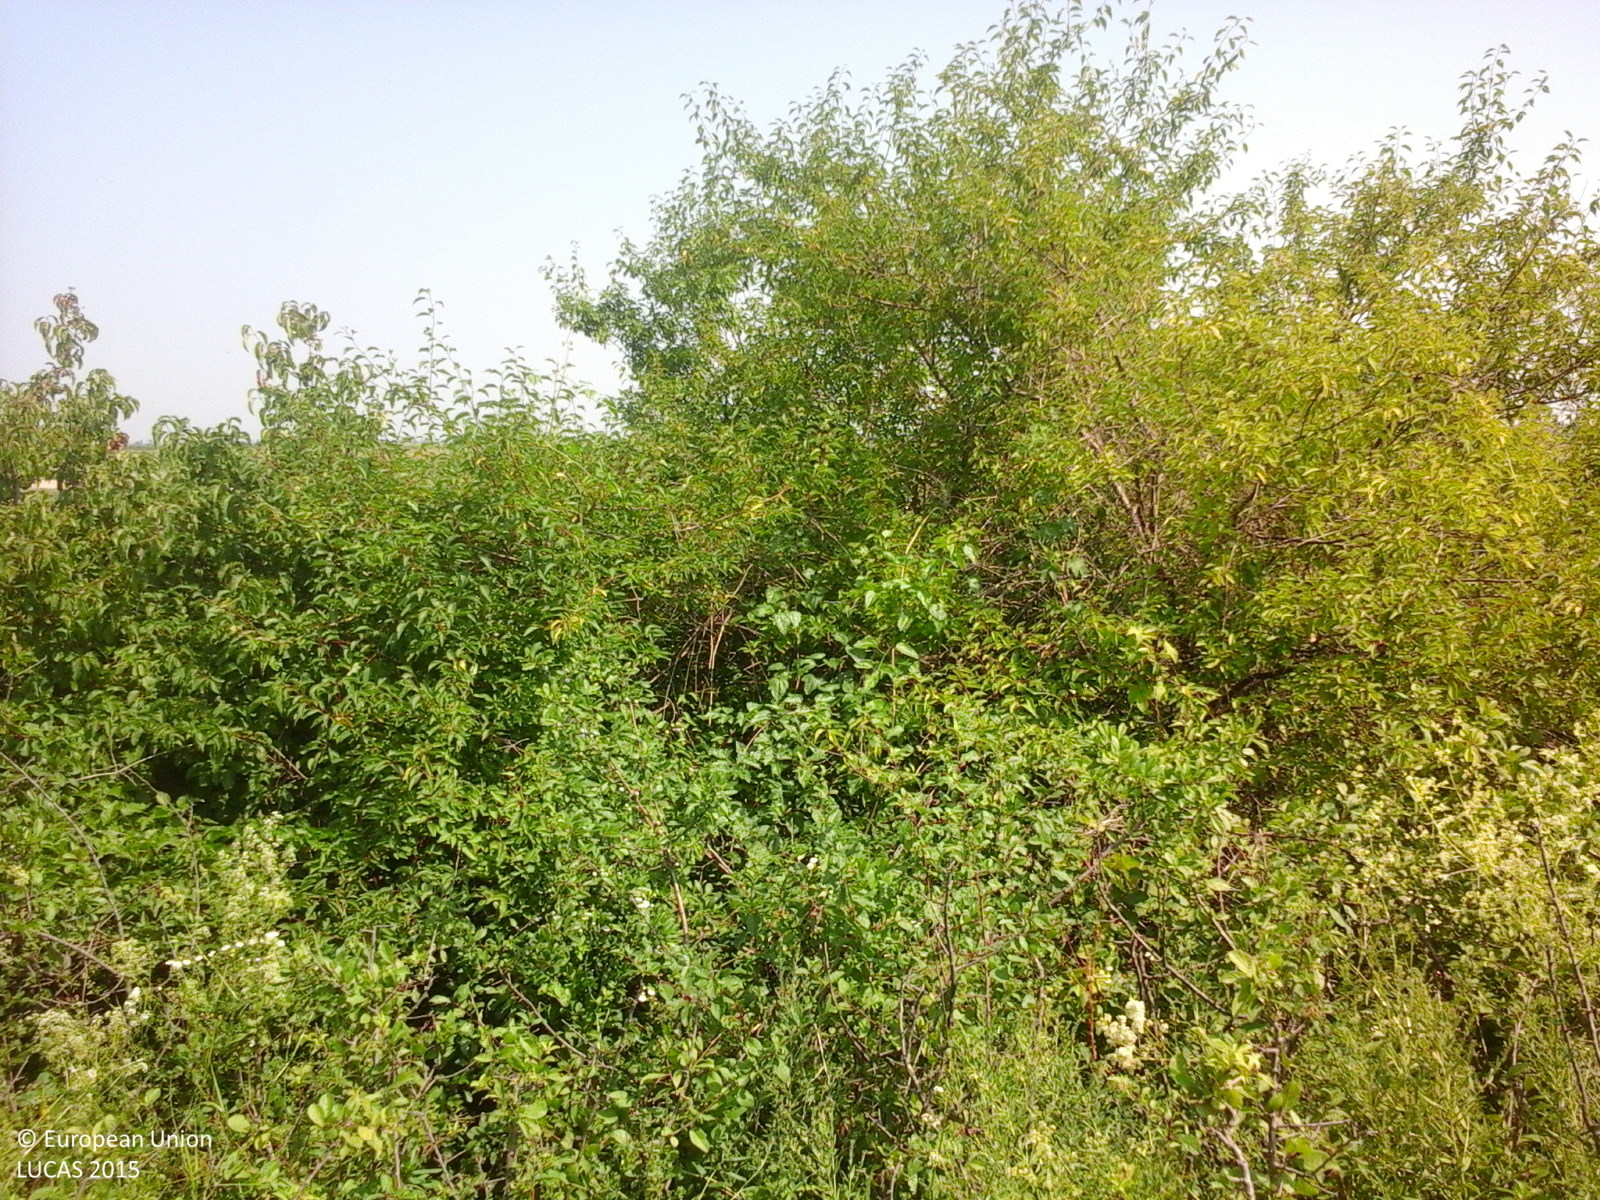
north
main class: Grassland
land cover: Grassland with sparse tree/shrub cover
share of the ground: > 75 %
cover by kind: herbaceous plants 95 %, broadleaved forest trees 5 %
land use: Agriculture (excluding fallow land and kitchen gardens)
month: July
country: RO
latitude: 44.5736
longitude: 25.7253
